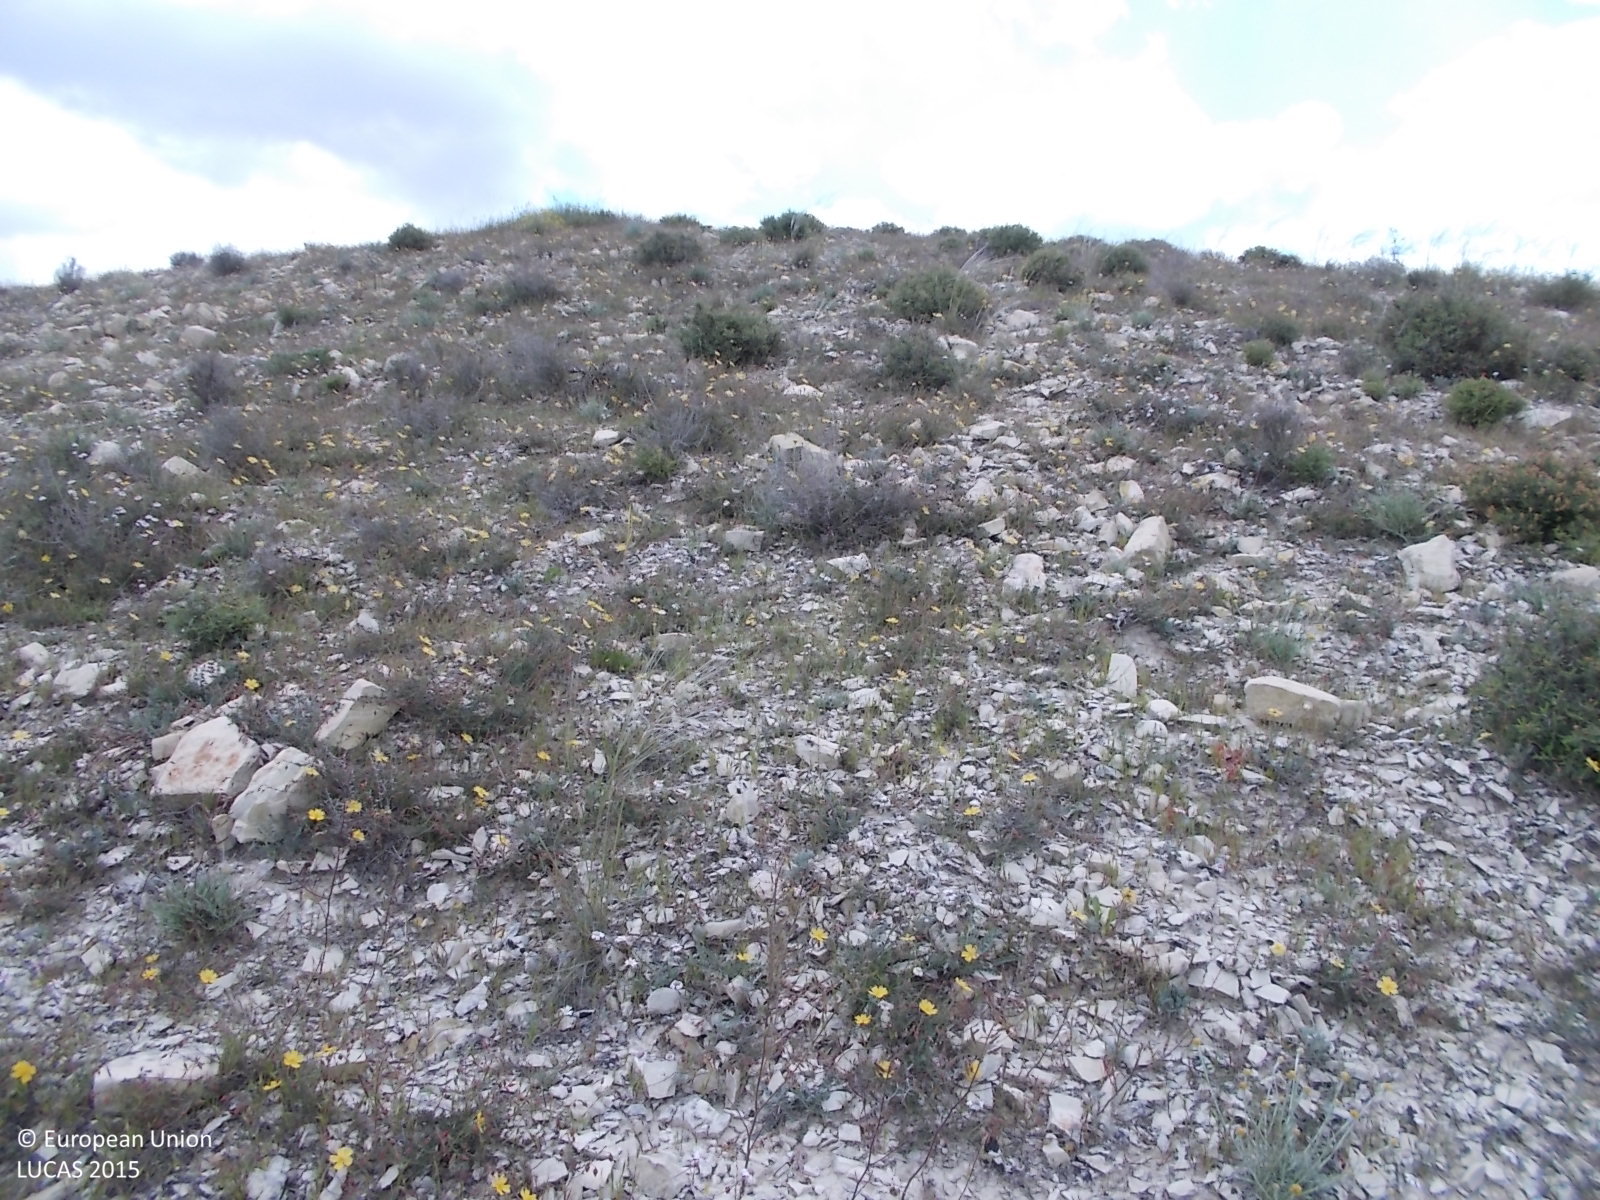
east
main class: Shrubland
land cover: Shrubland without tree cover
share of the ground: 25 - 50 %
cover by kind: unconsolidated bare surface 60 %, shrubs 40 %
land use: Semi-natural and natural areas not in use
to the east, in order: Shrubland without tree cover; Rocks and stones; Shrubland without tree cover; Rivers and streams; Shrubland without tree cover; Rocks and stones; Shrubland without tree cover
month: April
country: CY
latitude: 34.9735
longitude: 33.4673
